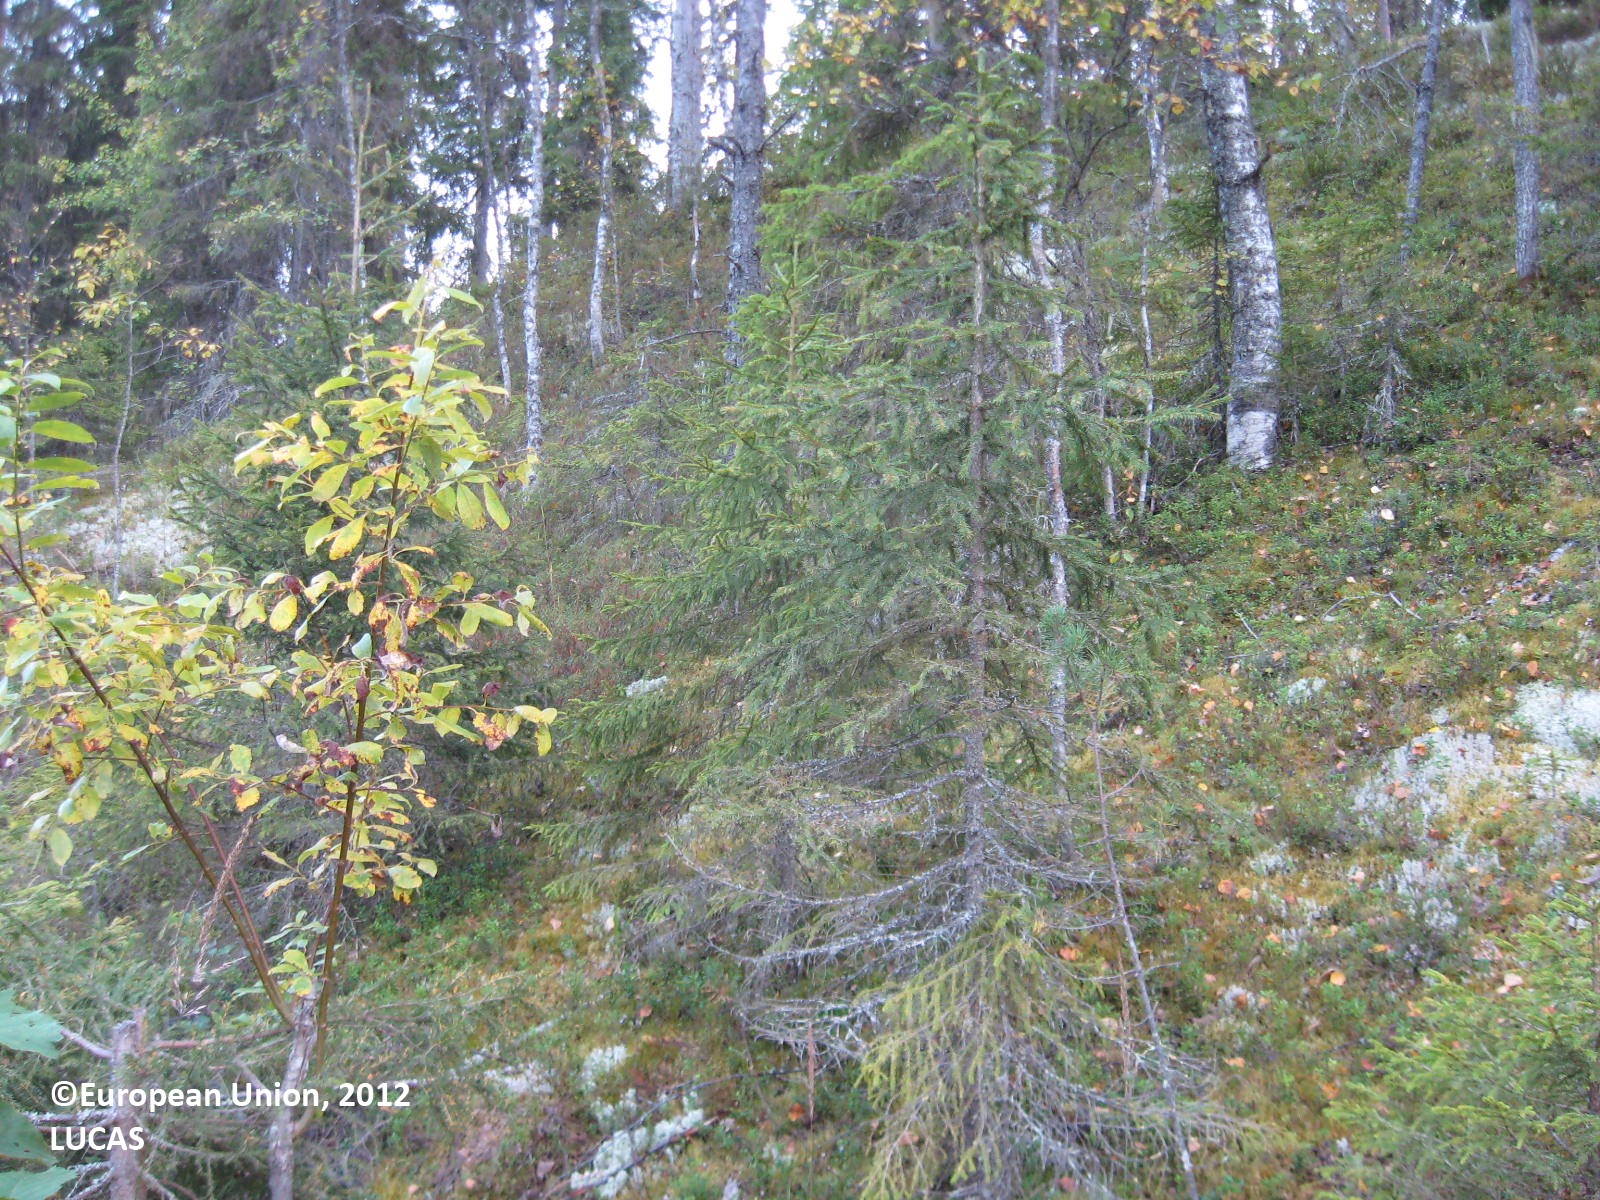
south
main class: Woodland
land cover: Other mixed woodland
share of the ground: > 75 %
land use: Forestry
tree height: < 5 m
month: August
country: FI
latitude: 63.9363
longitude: 28.4390
